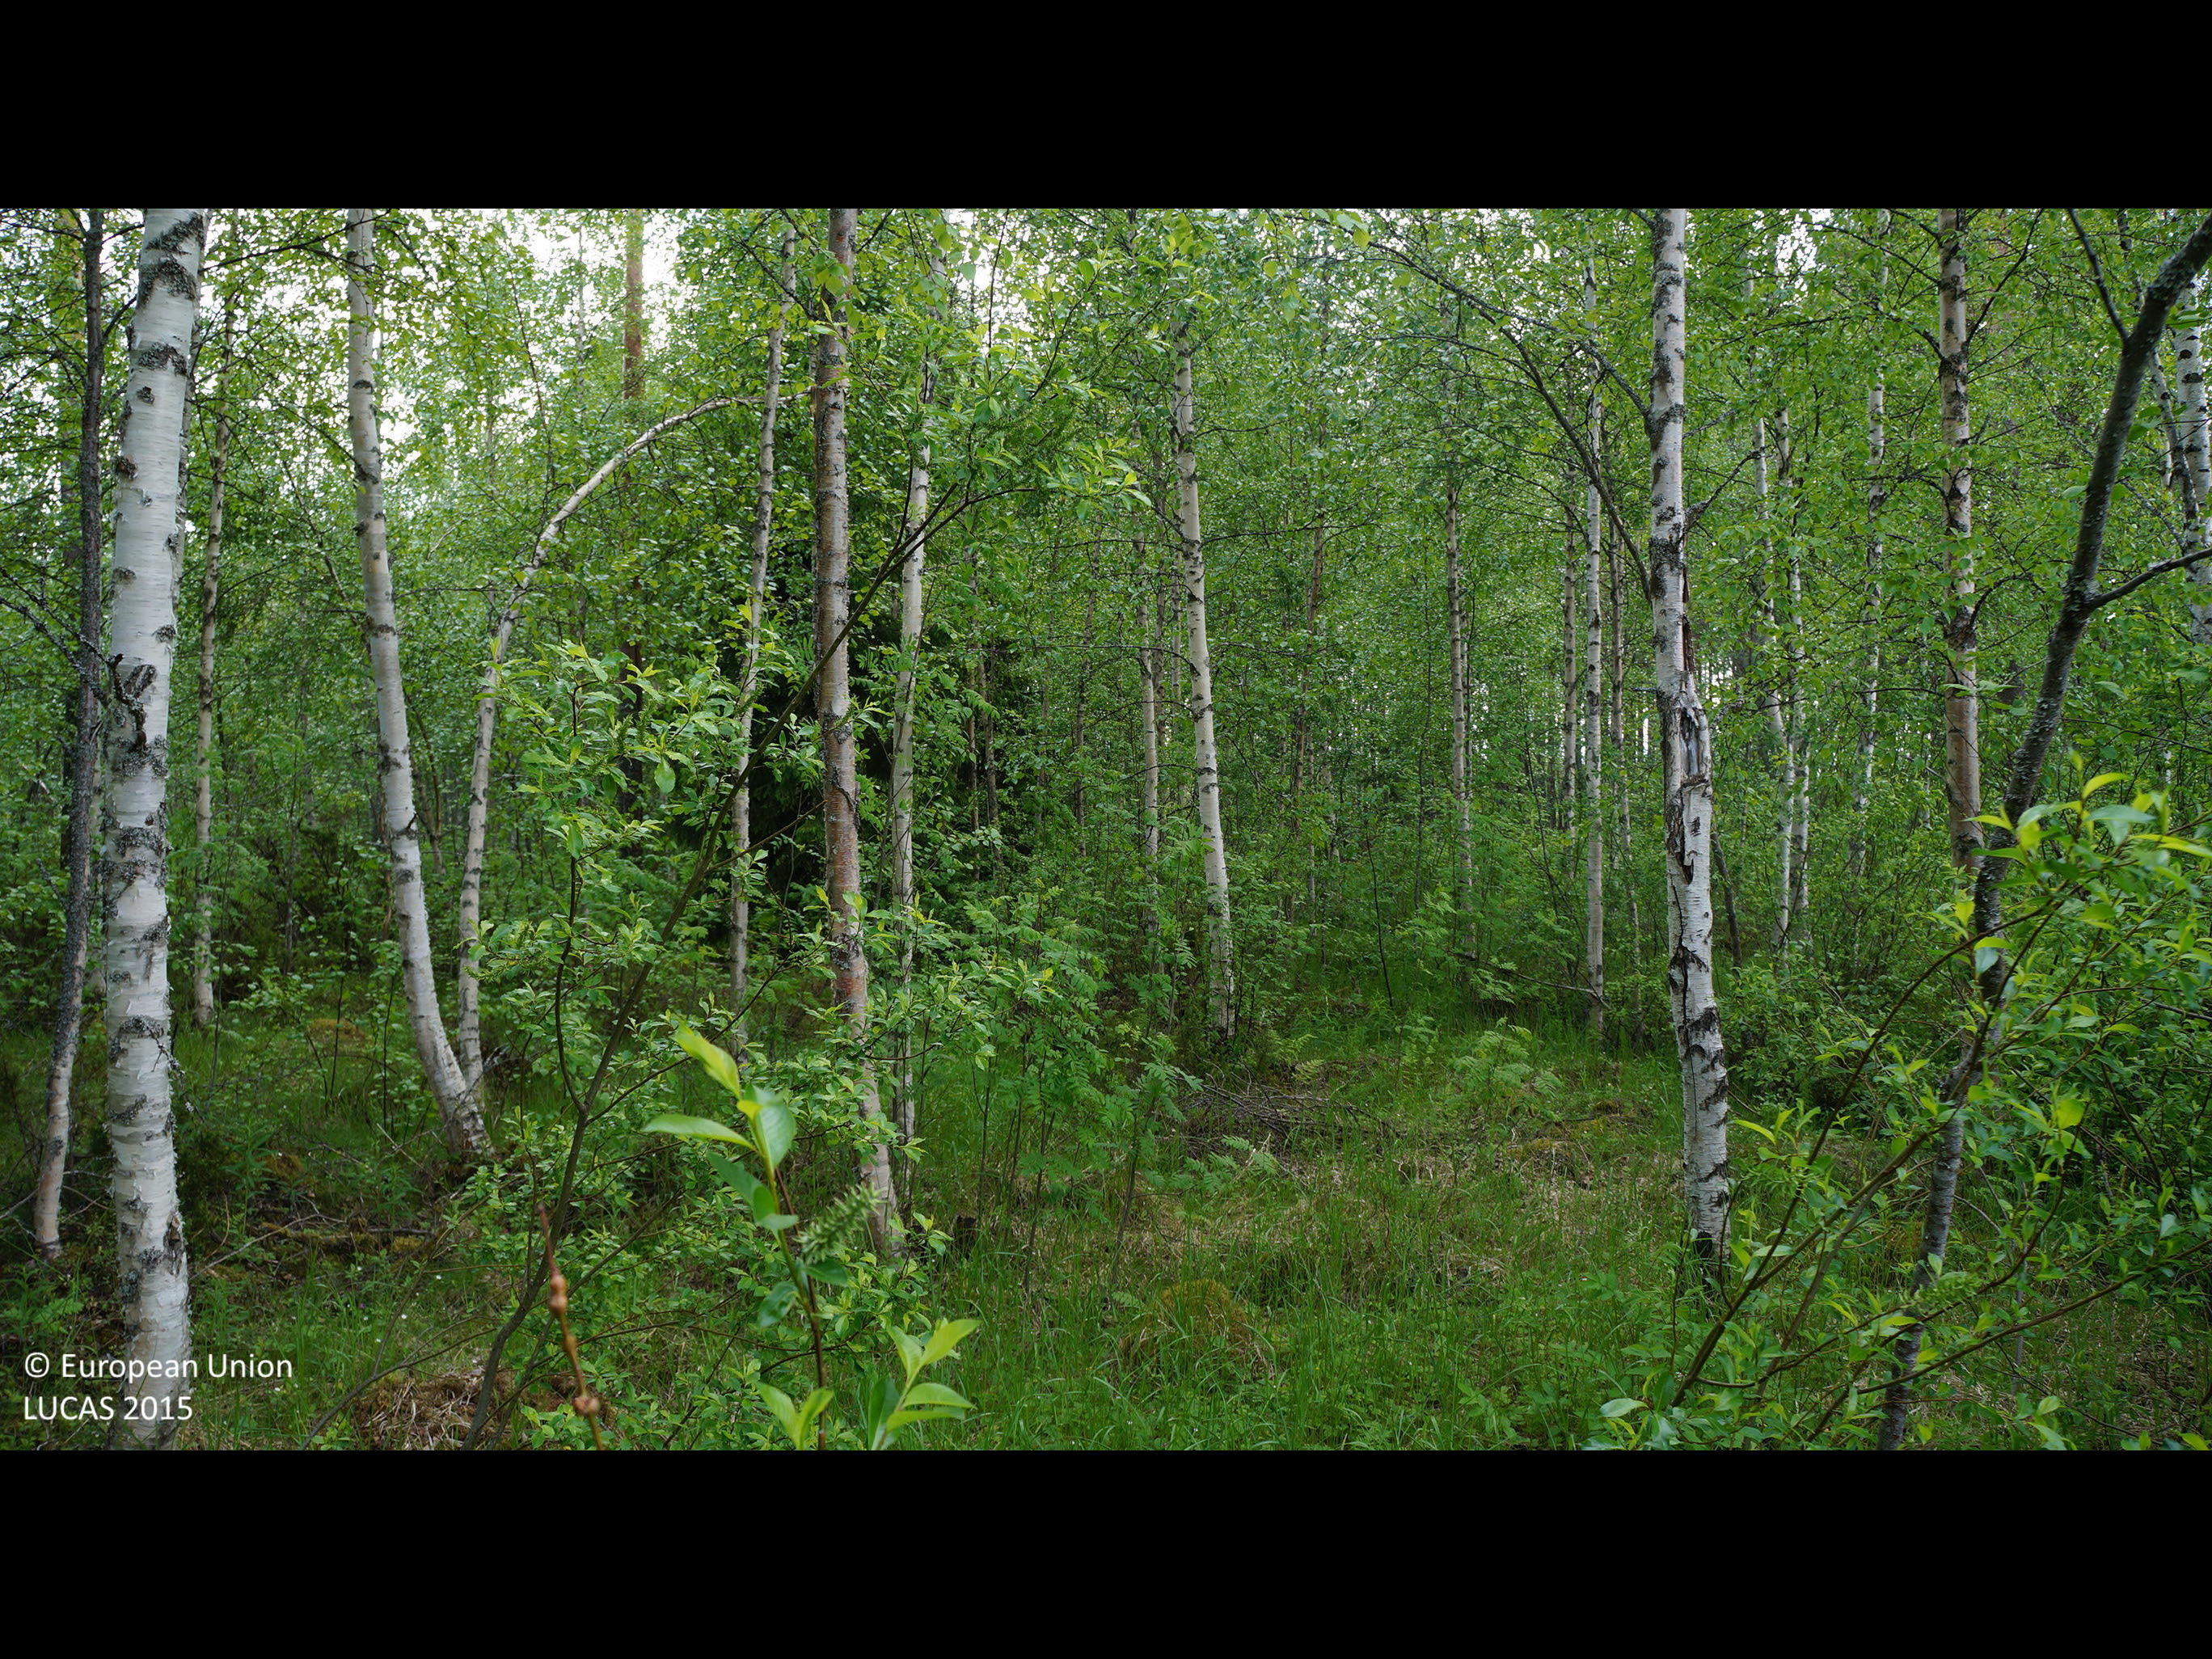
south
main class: Woodland
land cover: Broadleaved woodland
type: non-riverine alder, birch or aspen forest
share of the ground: 50 - 75 %
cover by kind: broadleaved forest trees 60 %, shrubs 20 %, herbaceous plants 15 %, coniferous forest trees 5 %
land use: Forestry
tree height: > 5 m
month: June
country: FI
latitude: 64.0920
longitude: 25.1226
